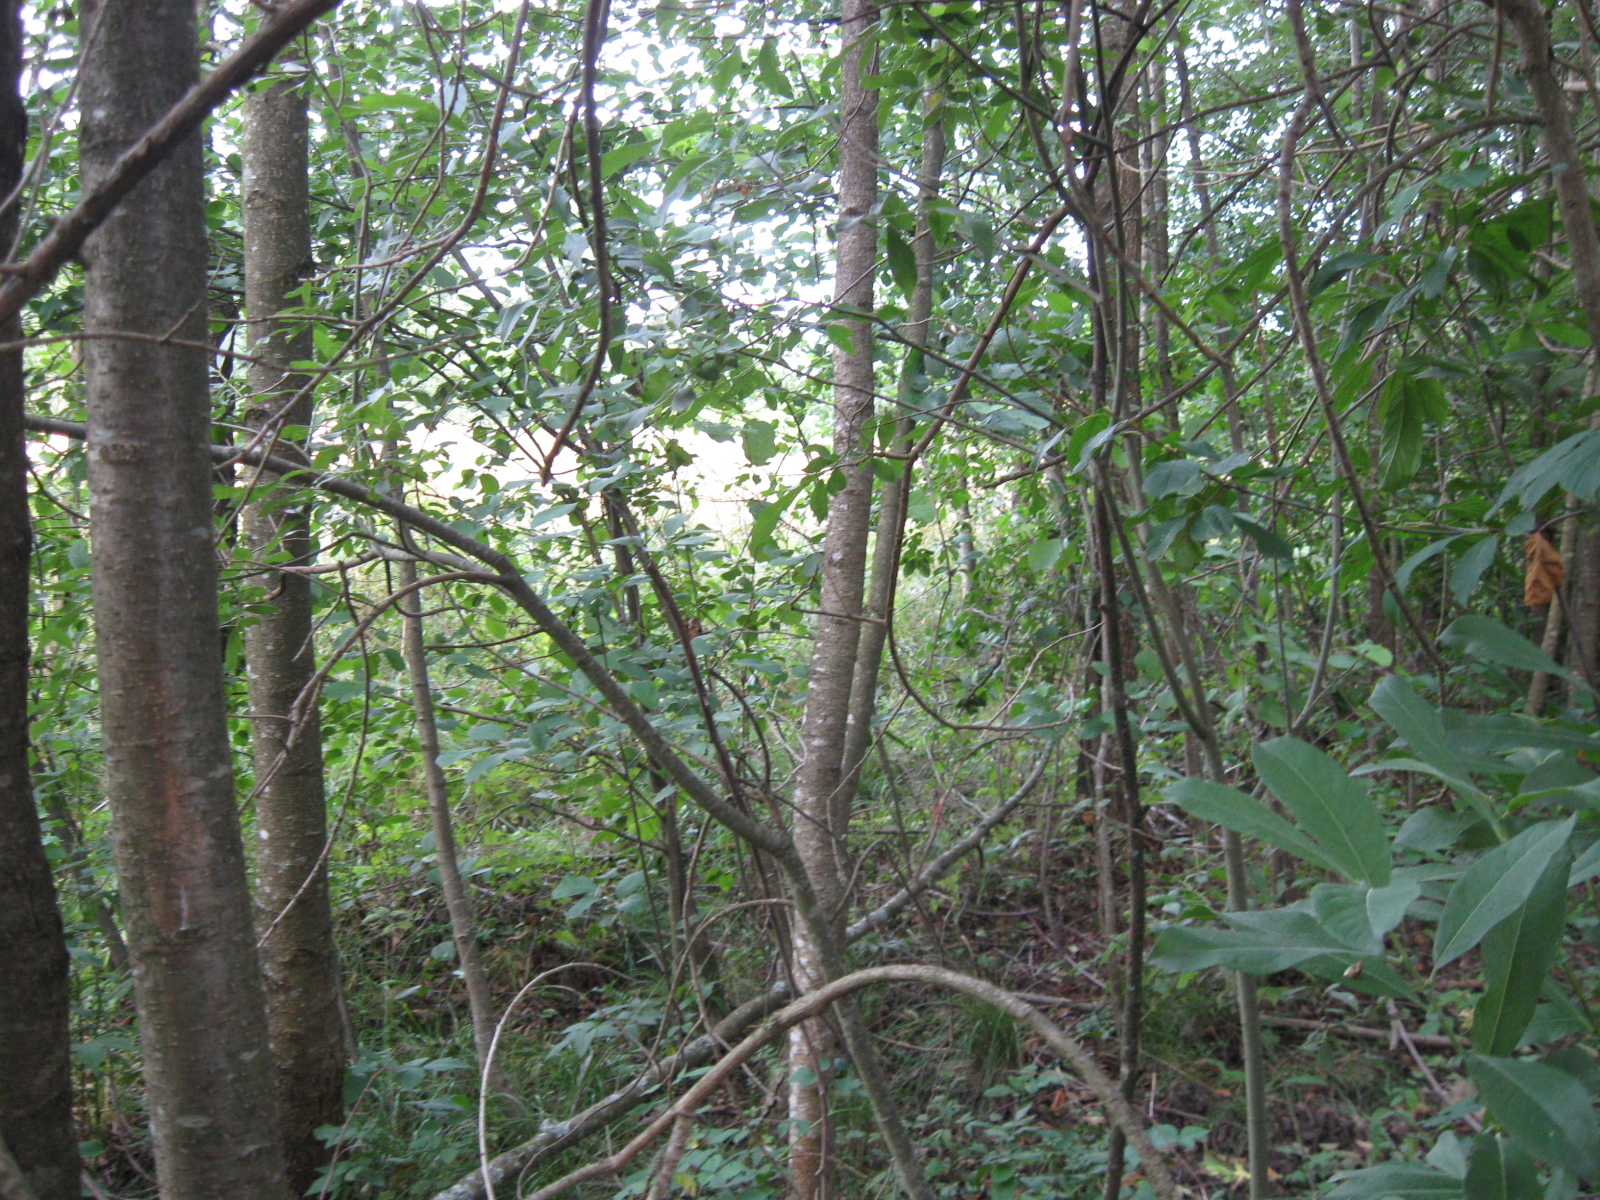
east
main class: Woodland
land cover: Broadleaved woodland
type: non-riverine alder, birch or aspen forest
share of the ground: > 75 %
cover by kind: broadleaved forest trees 80 %, herbaceous plants 15 %, coniferous forest trees 5 %
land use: Forestry
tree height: > 5 m
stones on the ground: < 10 %
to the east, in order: Broadleaved woodland; Grassland with sparse tree/shrub cover; Grassland without tree/shrub cover; Grassland with sparse tree/shrub cover; Broadleaved woodland; Other mixed woodland; Broadleaved woodland
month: July
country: LT
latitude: 54.6933
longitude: 23.7550
